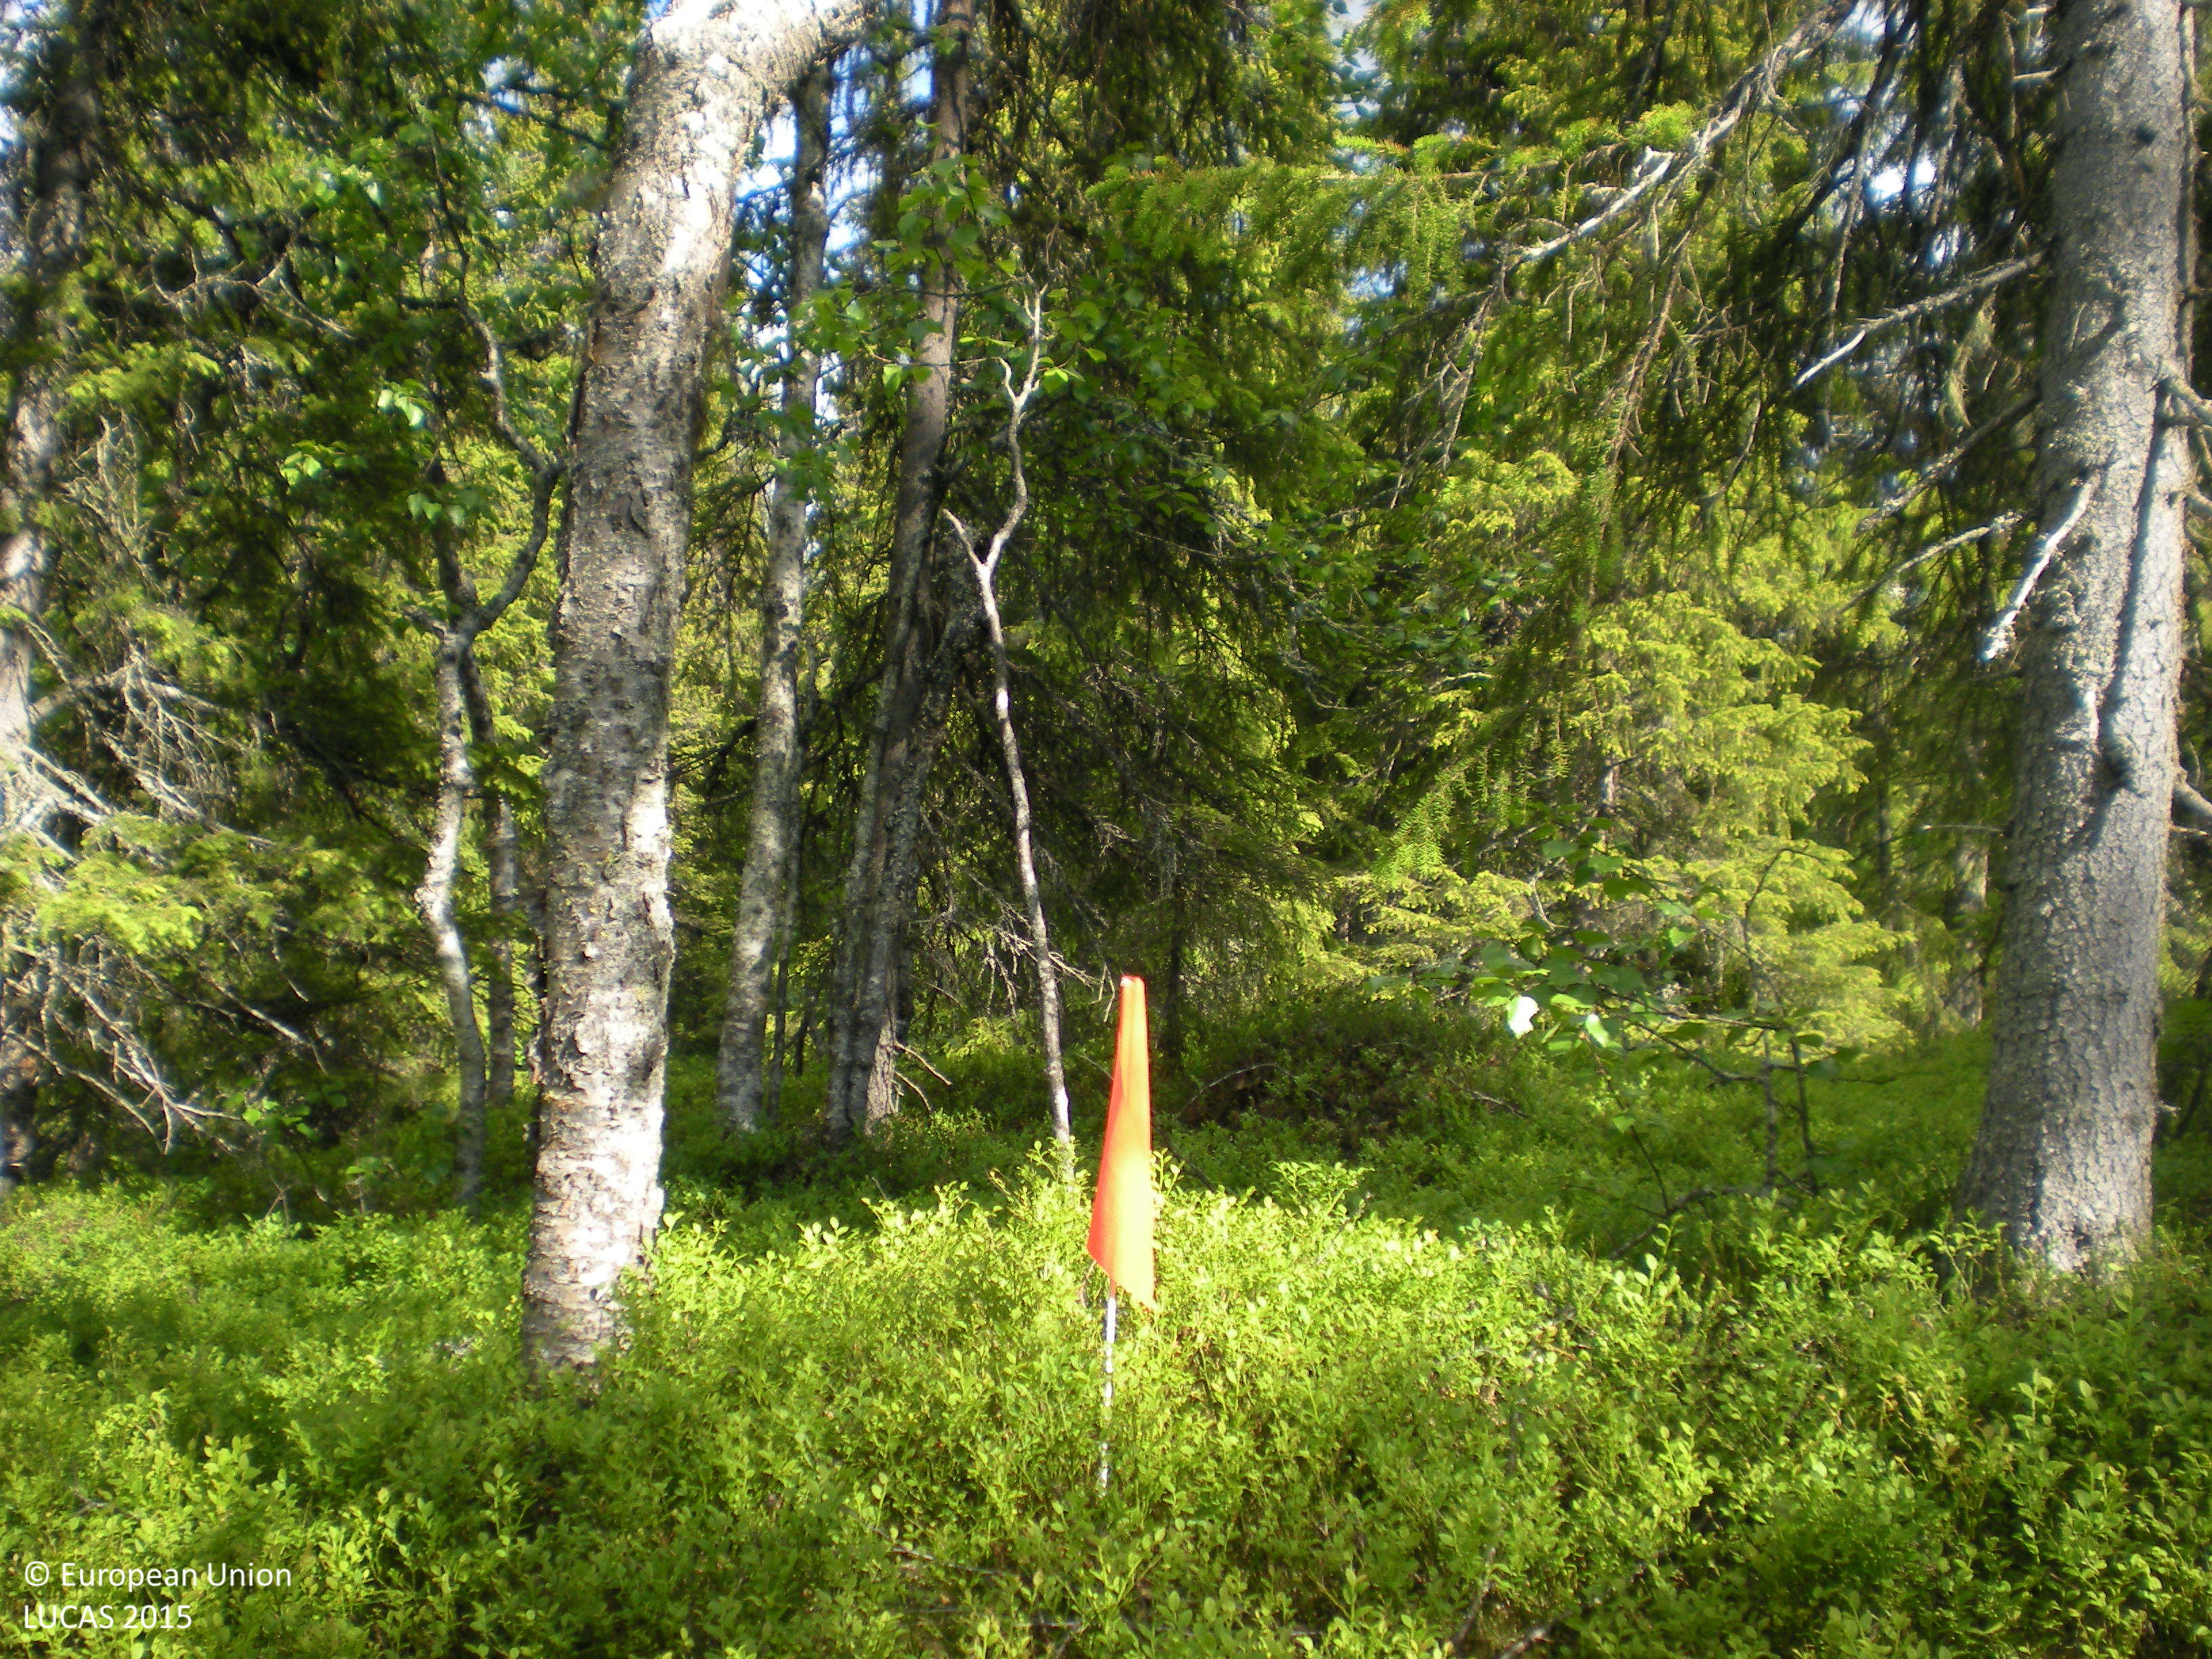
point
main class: Woodland
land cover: Spruce dominated mixed woodland
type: boreal forest
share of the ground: 50 - 75 %
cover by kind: coniferous forest trees 35 %, broadleaved forest trees 30 %, shrubs 25 %, lichens and mosses 10 %
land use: Forestry
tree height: > 5 m
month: July
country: SE
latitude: 65.5558
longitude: 16.8690
